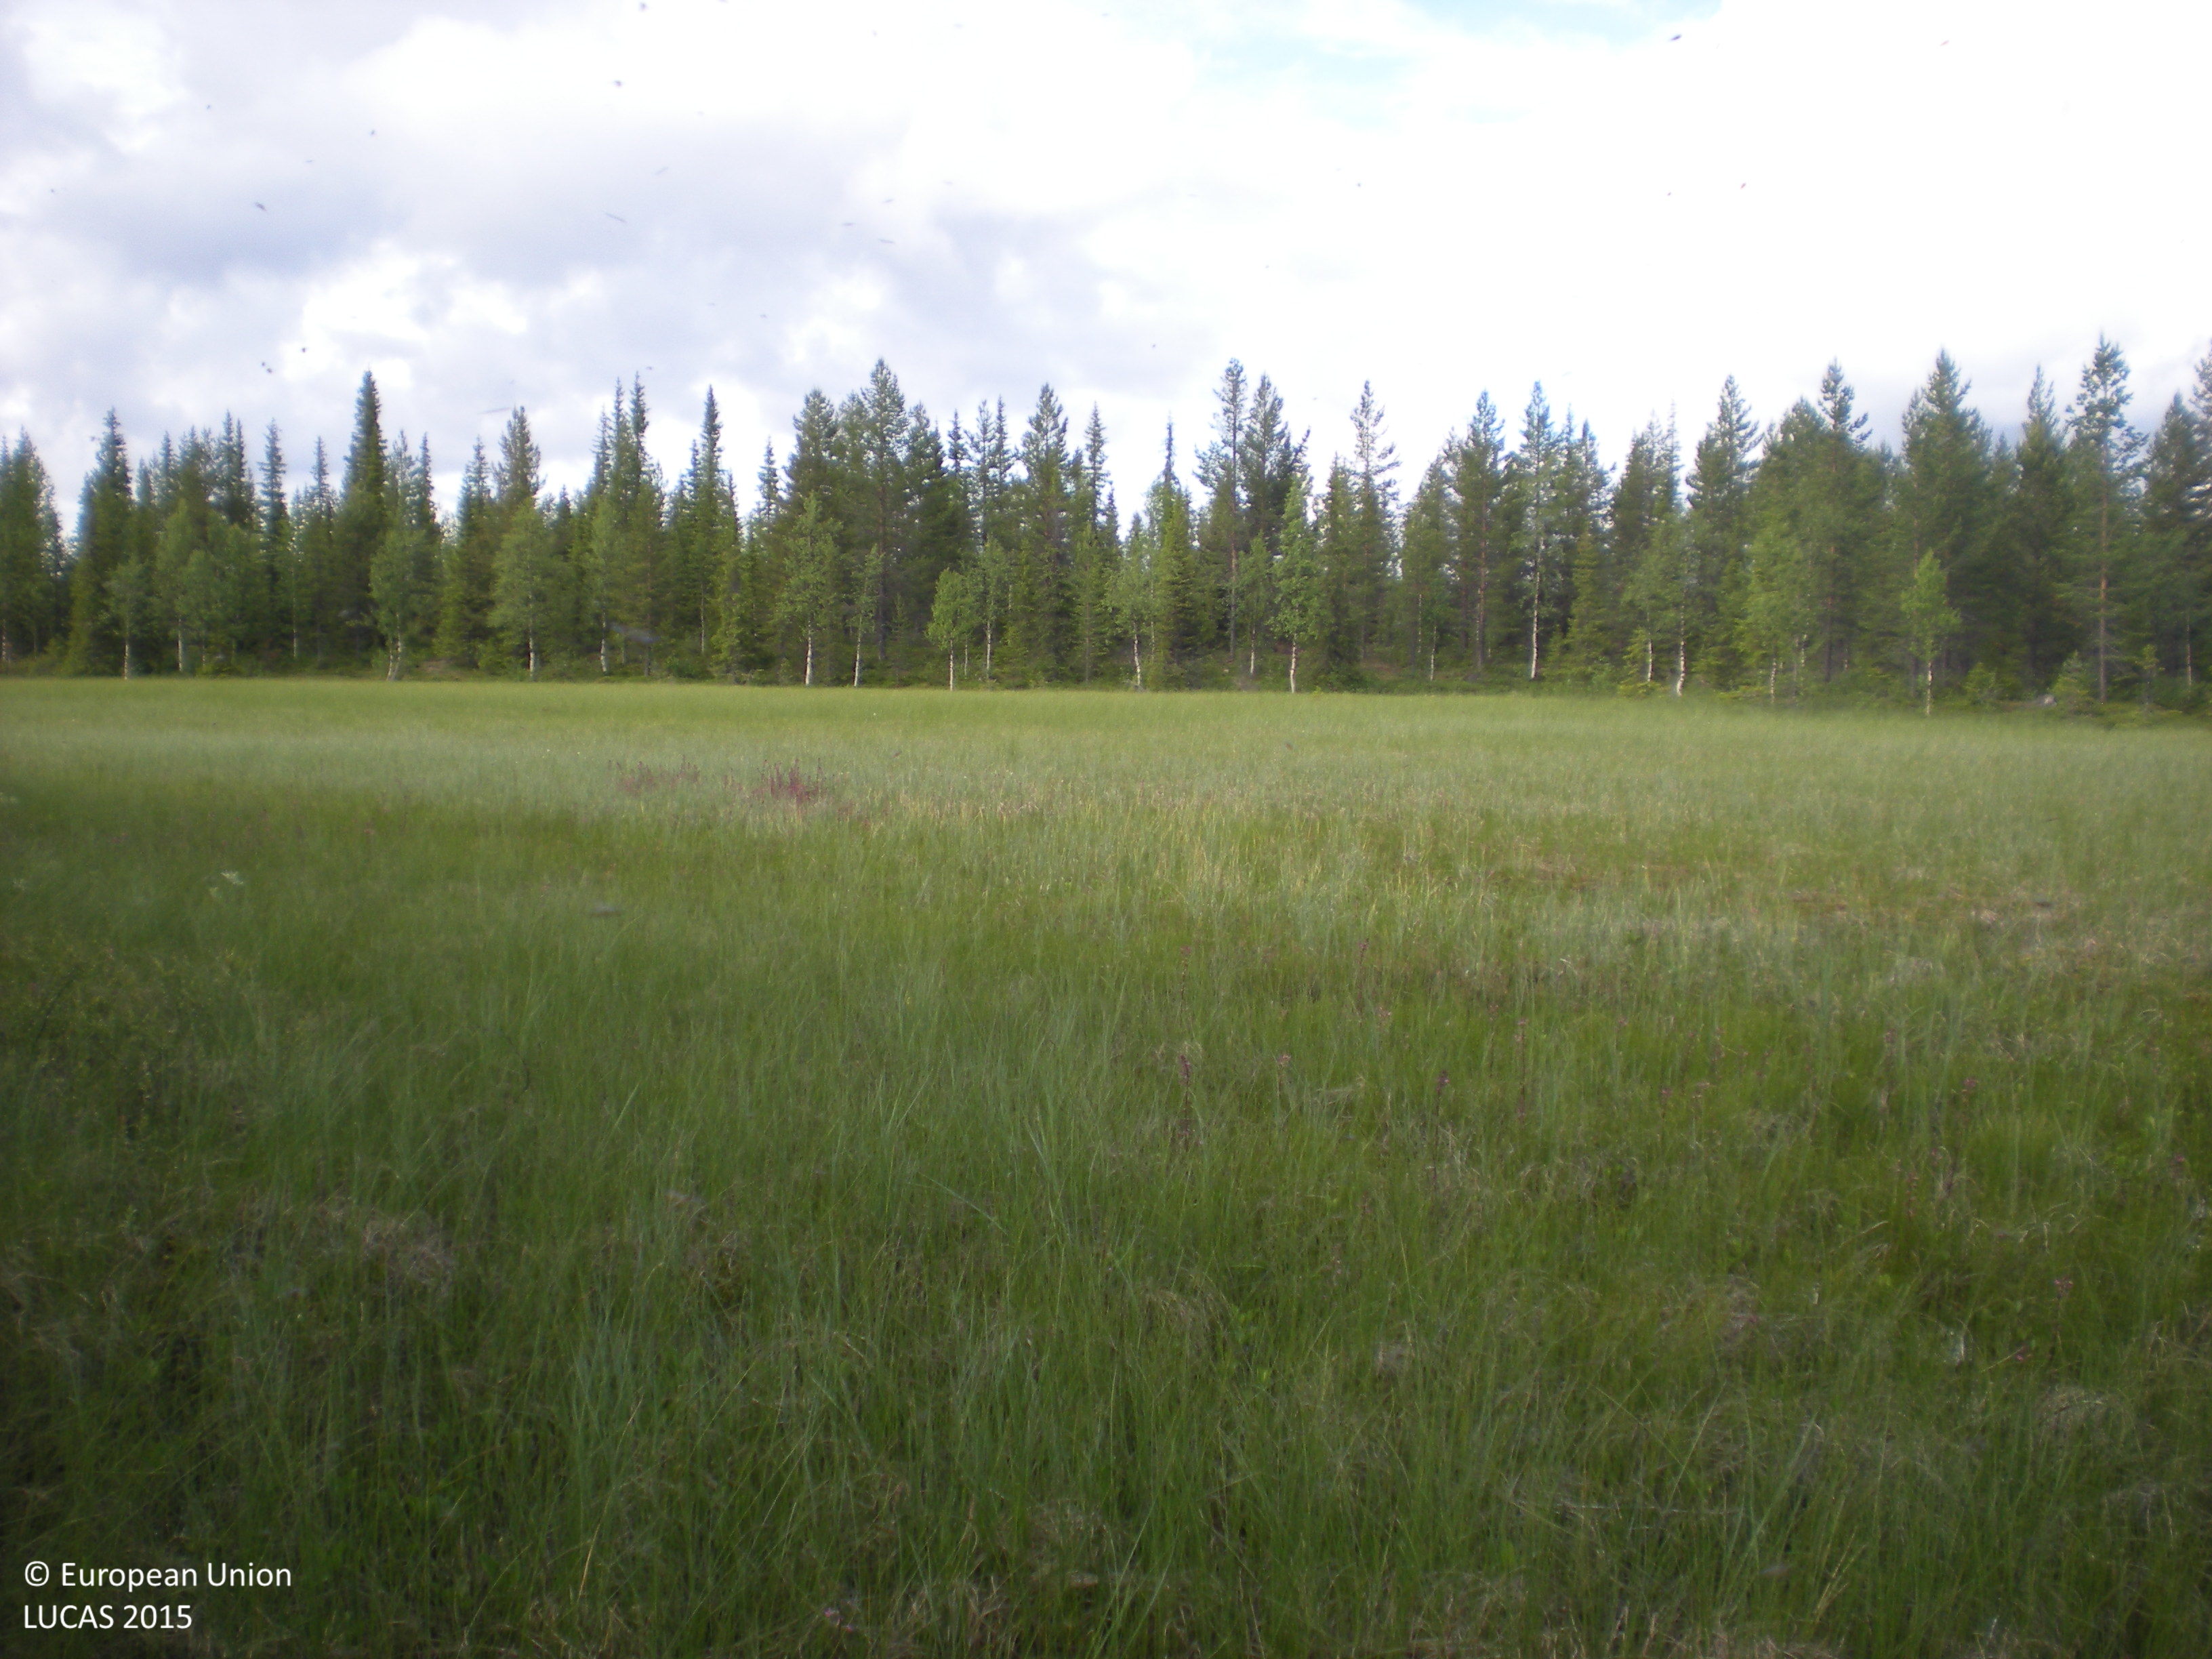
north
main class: Woodland
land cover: Spruce dominated mixed woodland
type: boreal forest
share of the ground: 50 - 75 %
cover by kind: coniferous forest trees 35 %, shrubs 30 %, broadleaved forest trees 25 %, lichens and mosses 10 %
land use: Forestry
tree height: > 5 m
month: July
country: SE
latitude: 65.6994
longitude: 17.7326
